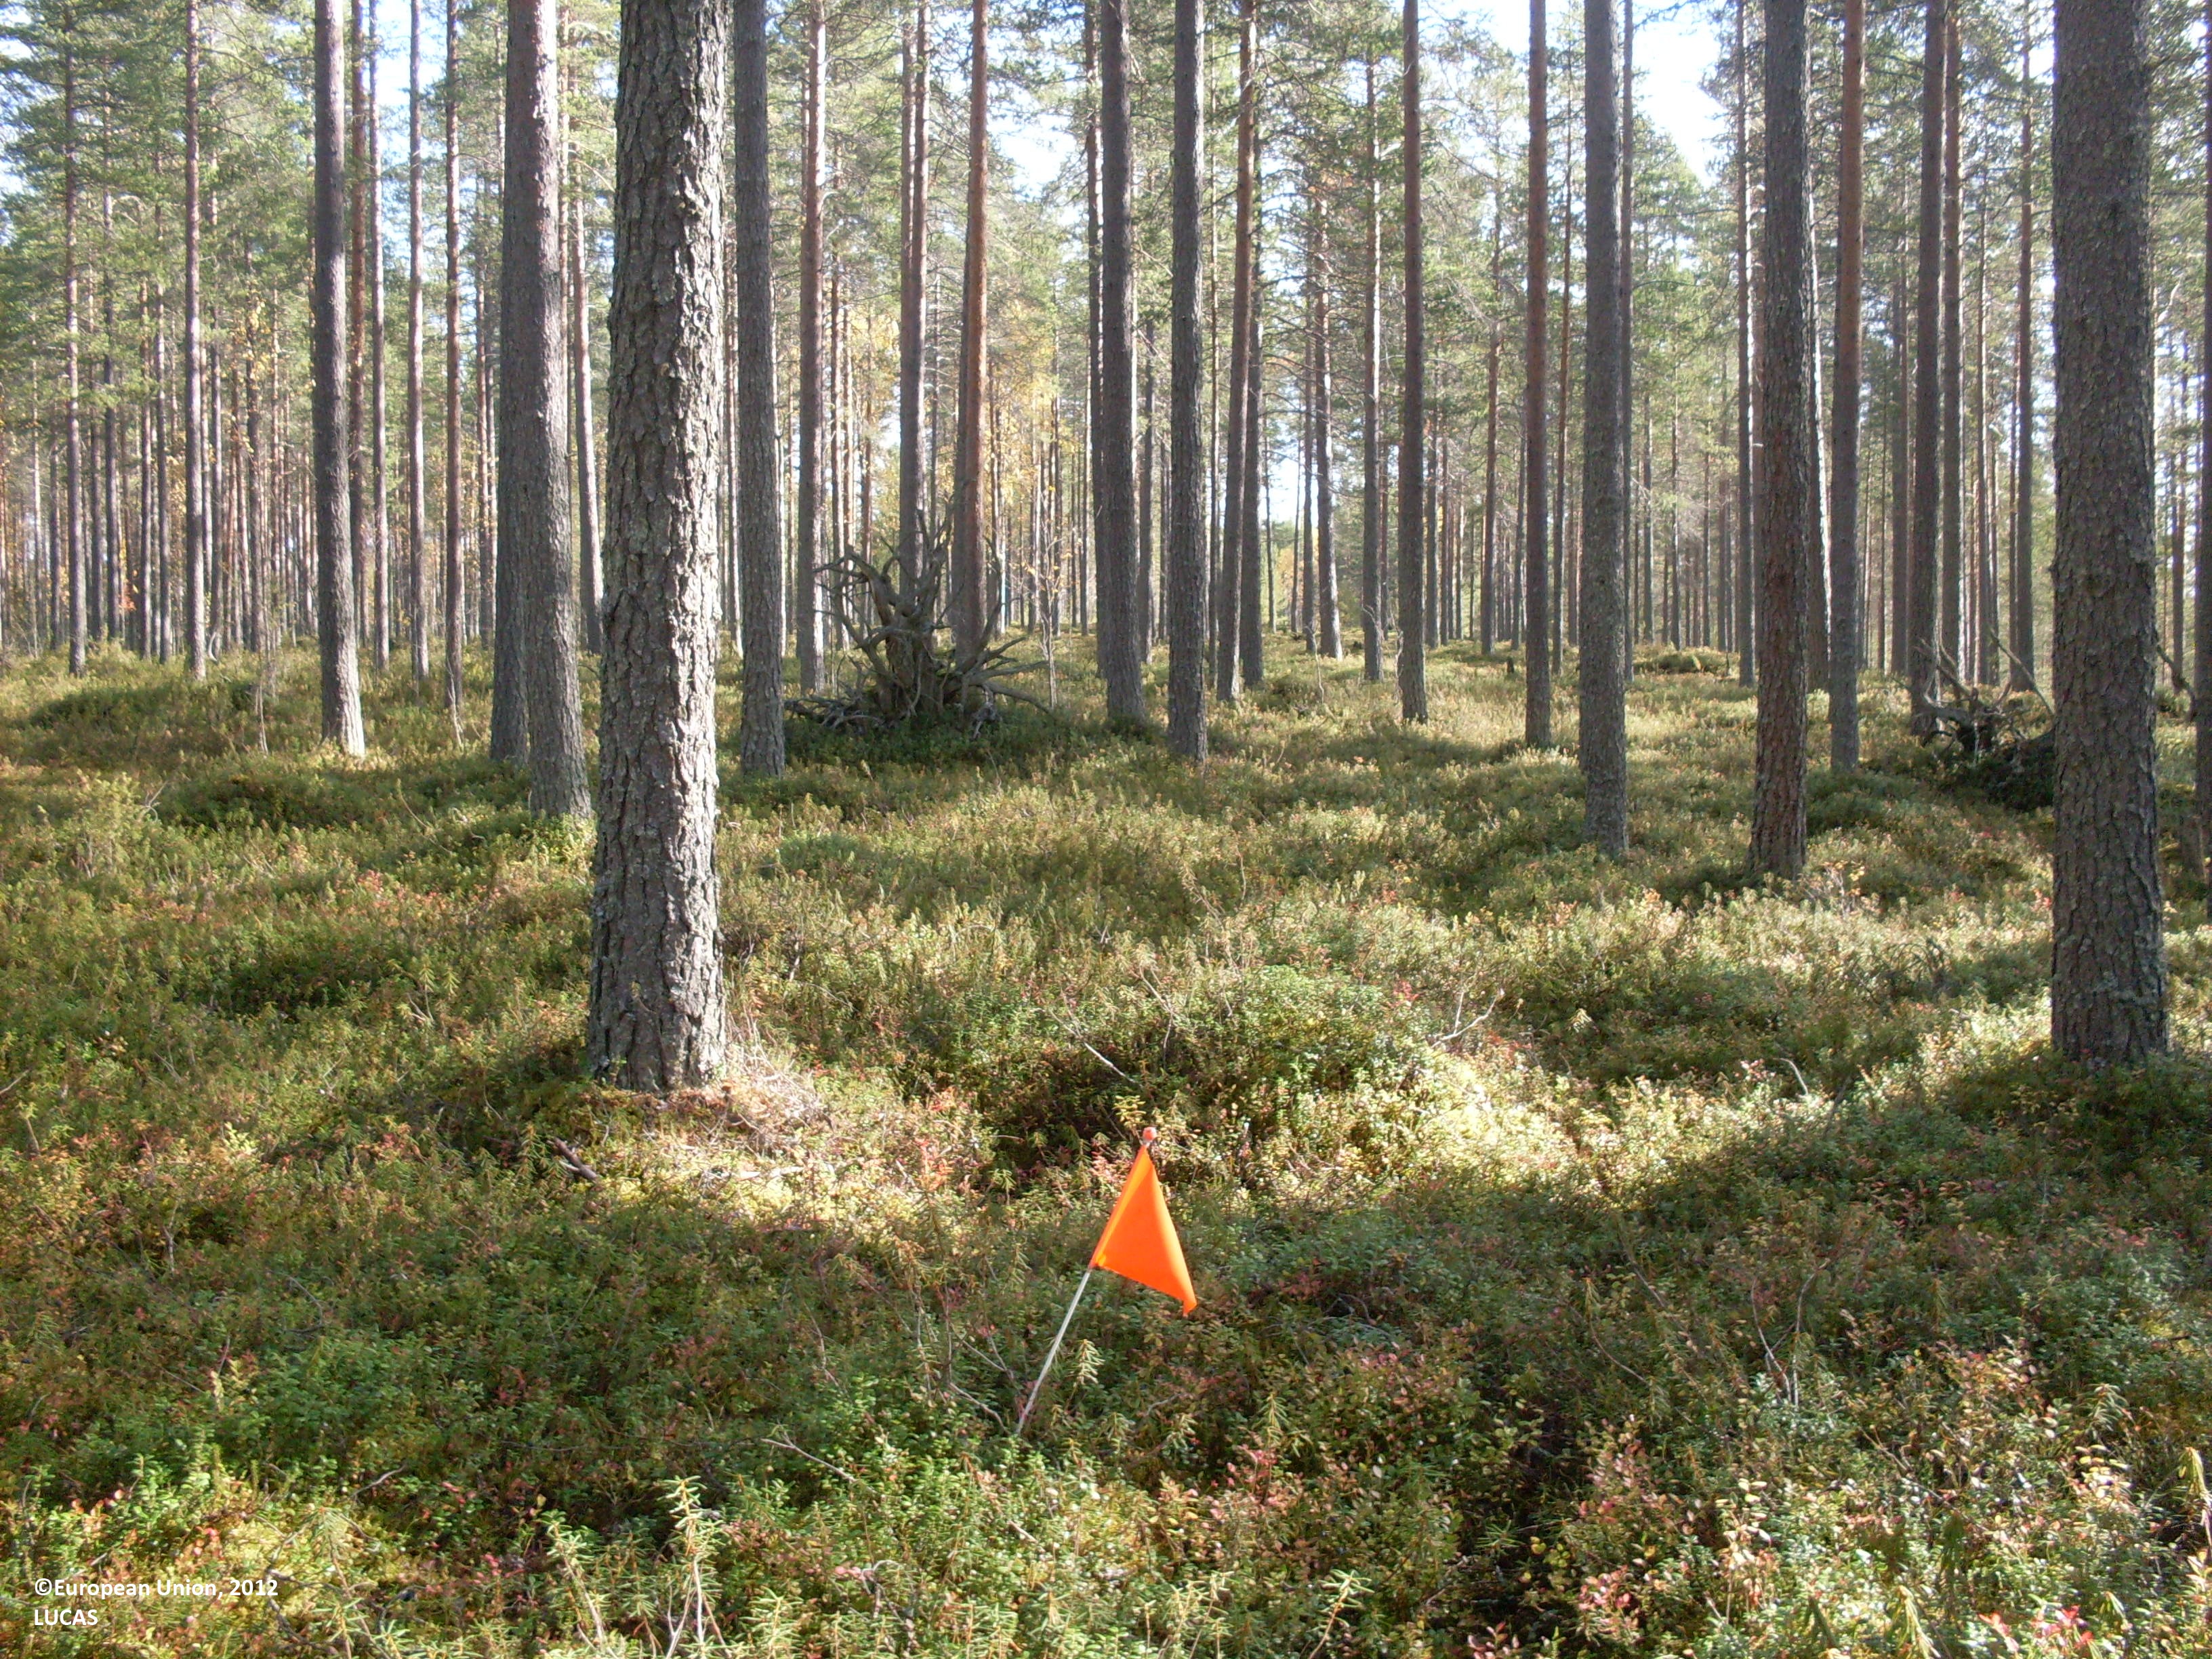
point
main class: Woodland
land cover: Pine dominated coniferous woodland
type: boreal forest
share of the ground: 50 - 75 %
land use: Forestry
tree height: > 5 m
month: September
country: FI
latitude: 64.7439
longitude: 29.3399
